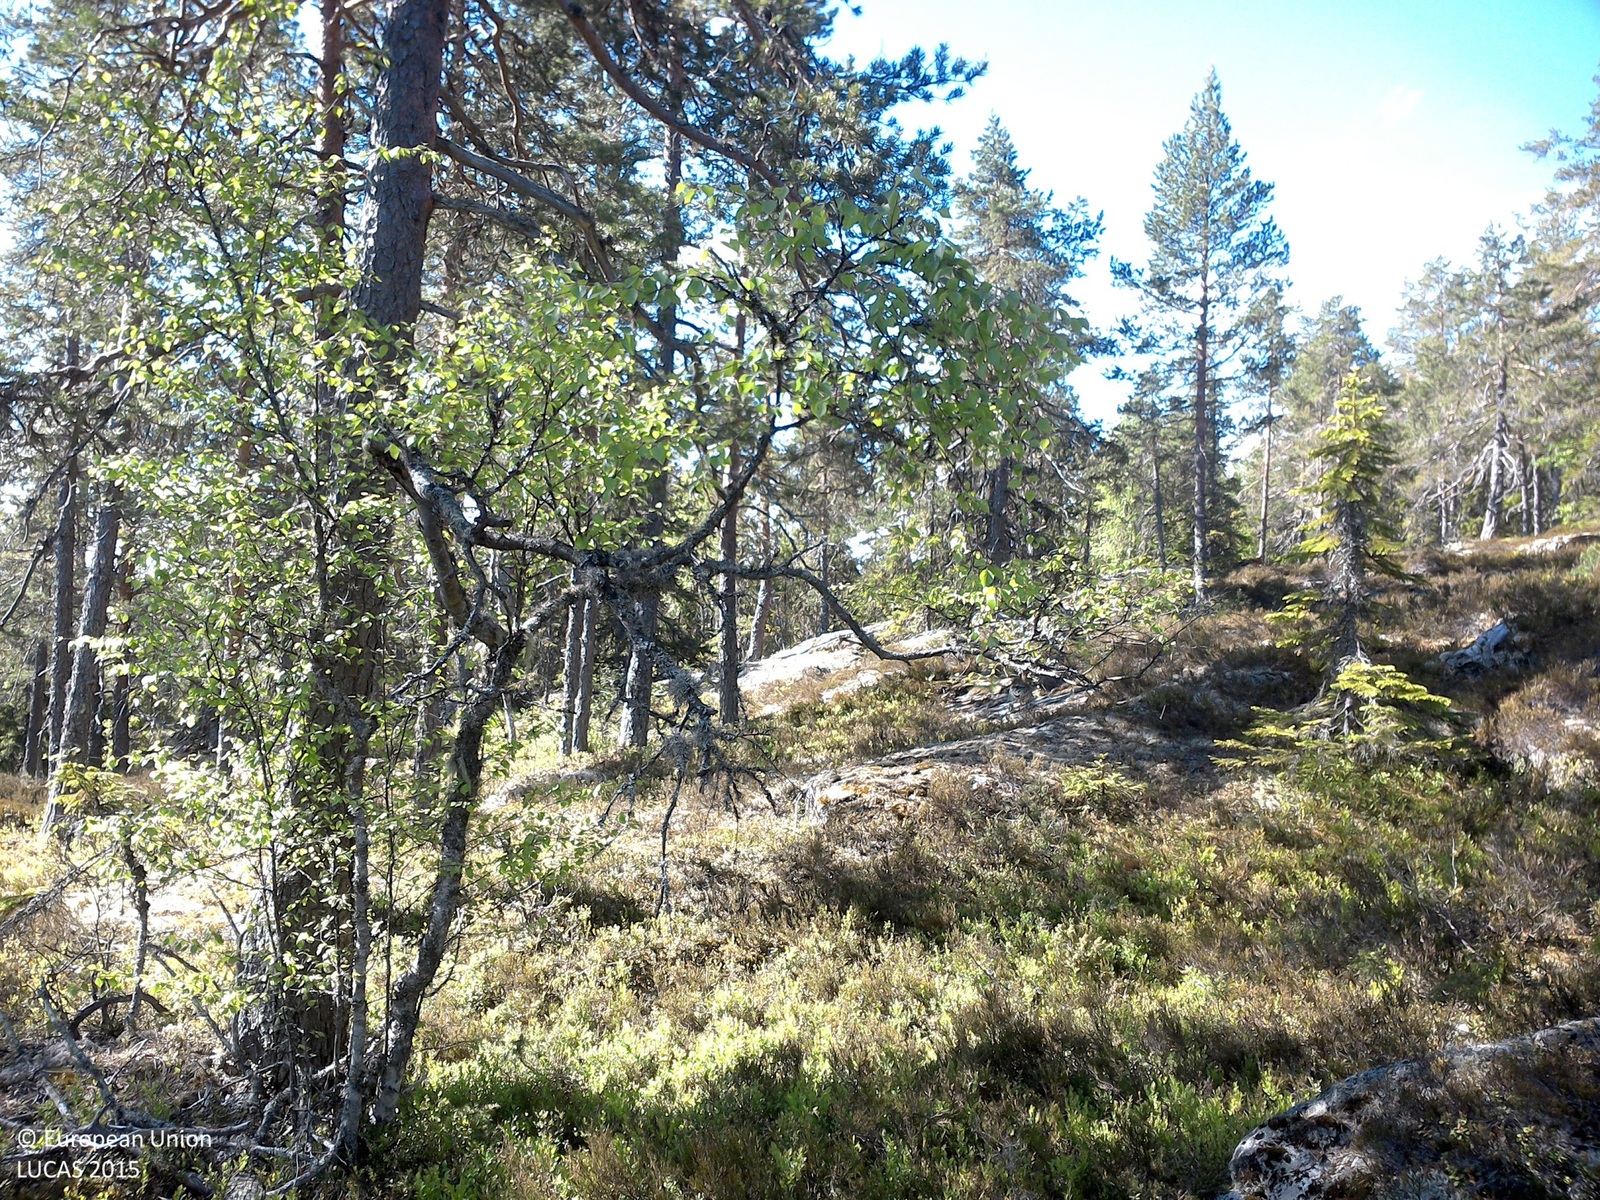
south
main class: Woodland
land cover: Pine dominated coniferous woodland
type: boreal forest
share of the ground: 10 - 25 %
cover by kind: shrubs 70 %, coniferous forest trees 20 %, lichens and mosses 10 %
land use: Forestry
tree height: > 5 m
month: June
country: SE
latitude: 62.6834
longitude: 17.7731
